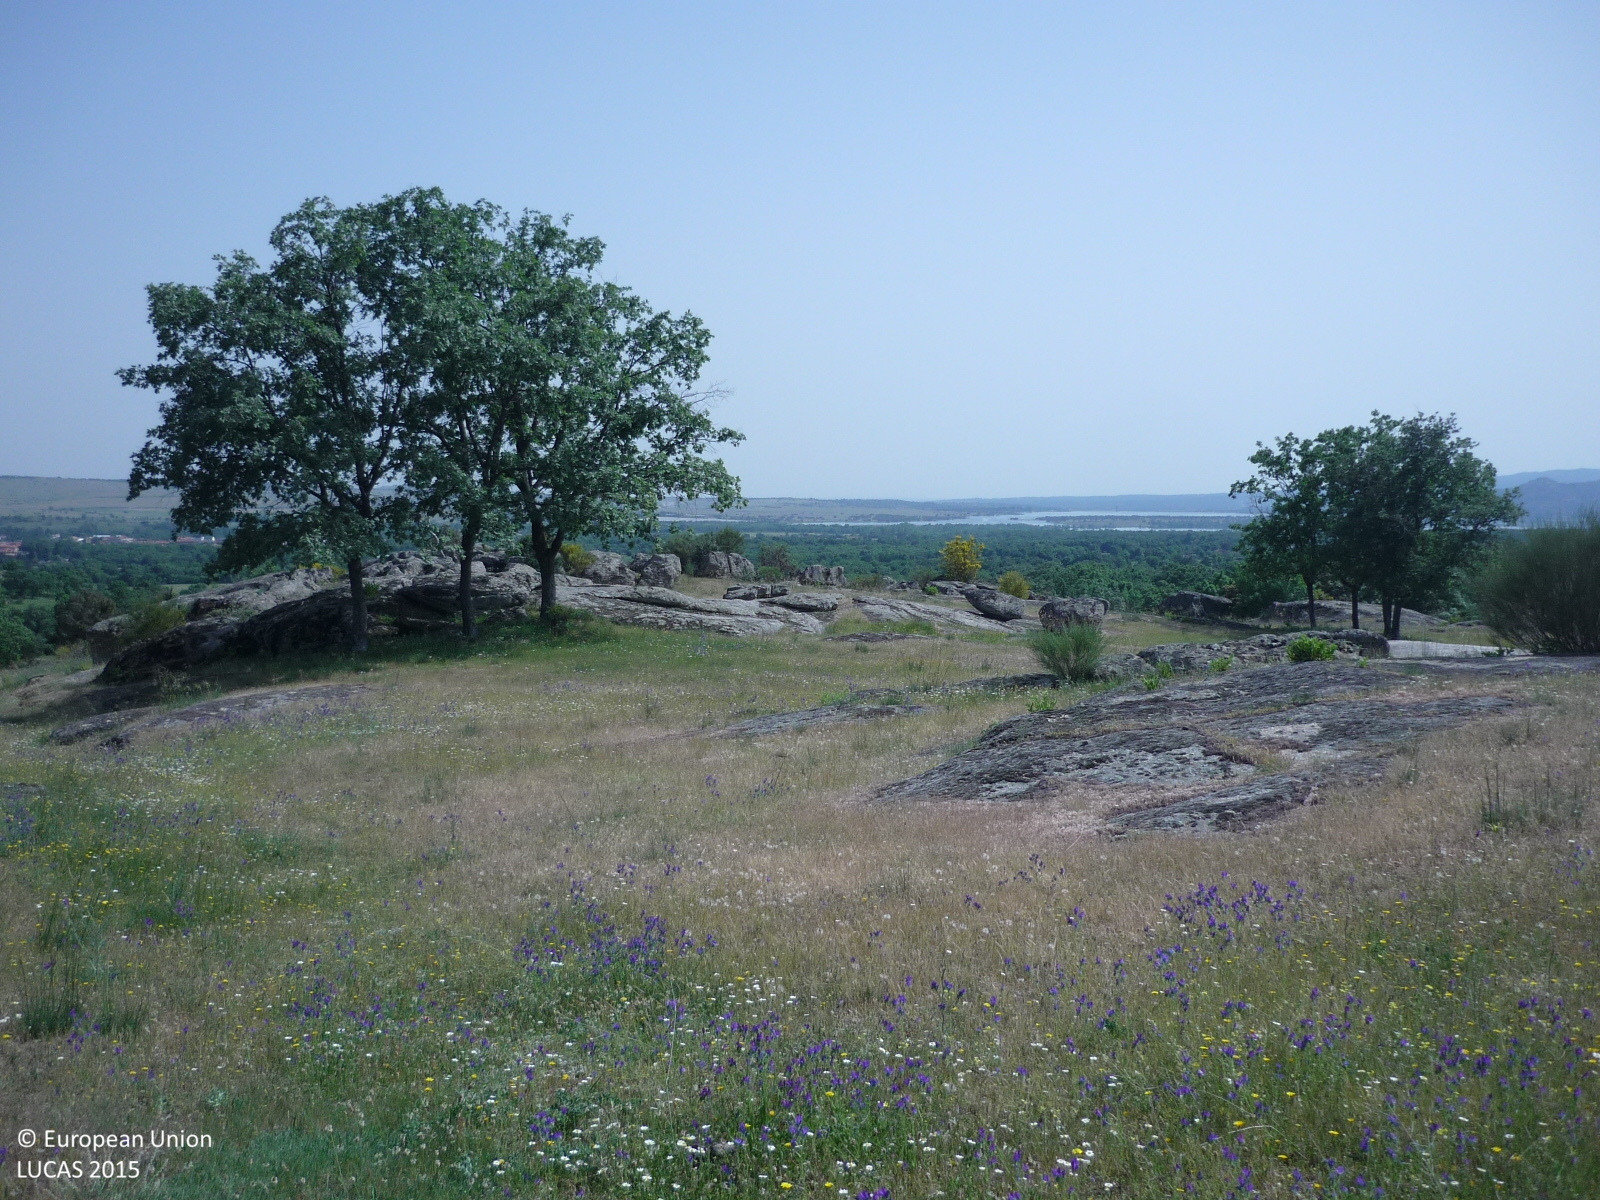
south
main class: Grassland
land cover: Grassland with sparse tree/shrub cover
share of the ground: > 75 %
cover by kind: herbaceous plants 85 %, shrubs 10 %, broadleaved forest trees 5 %
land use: Agriculture (excluding fallow land and kitchen gardens)
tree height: < 5 m
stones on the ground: < 10 %
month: May
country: ES
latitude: 40.7711
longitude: -3.7984
